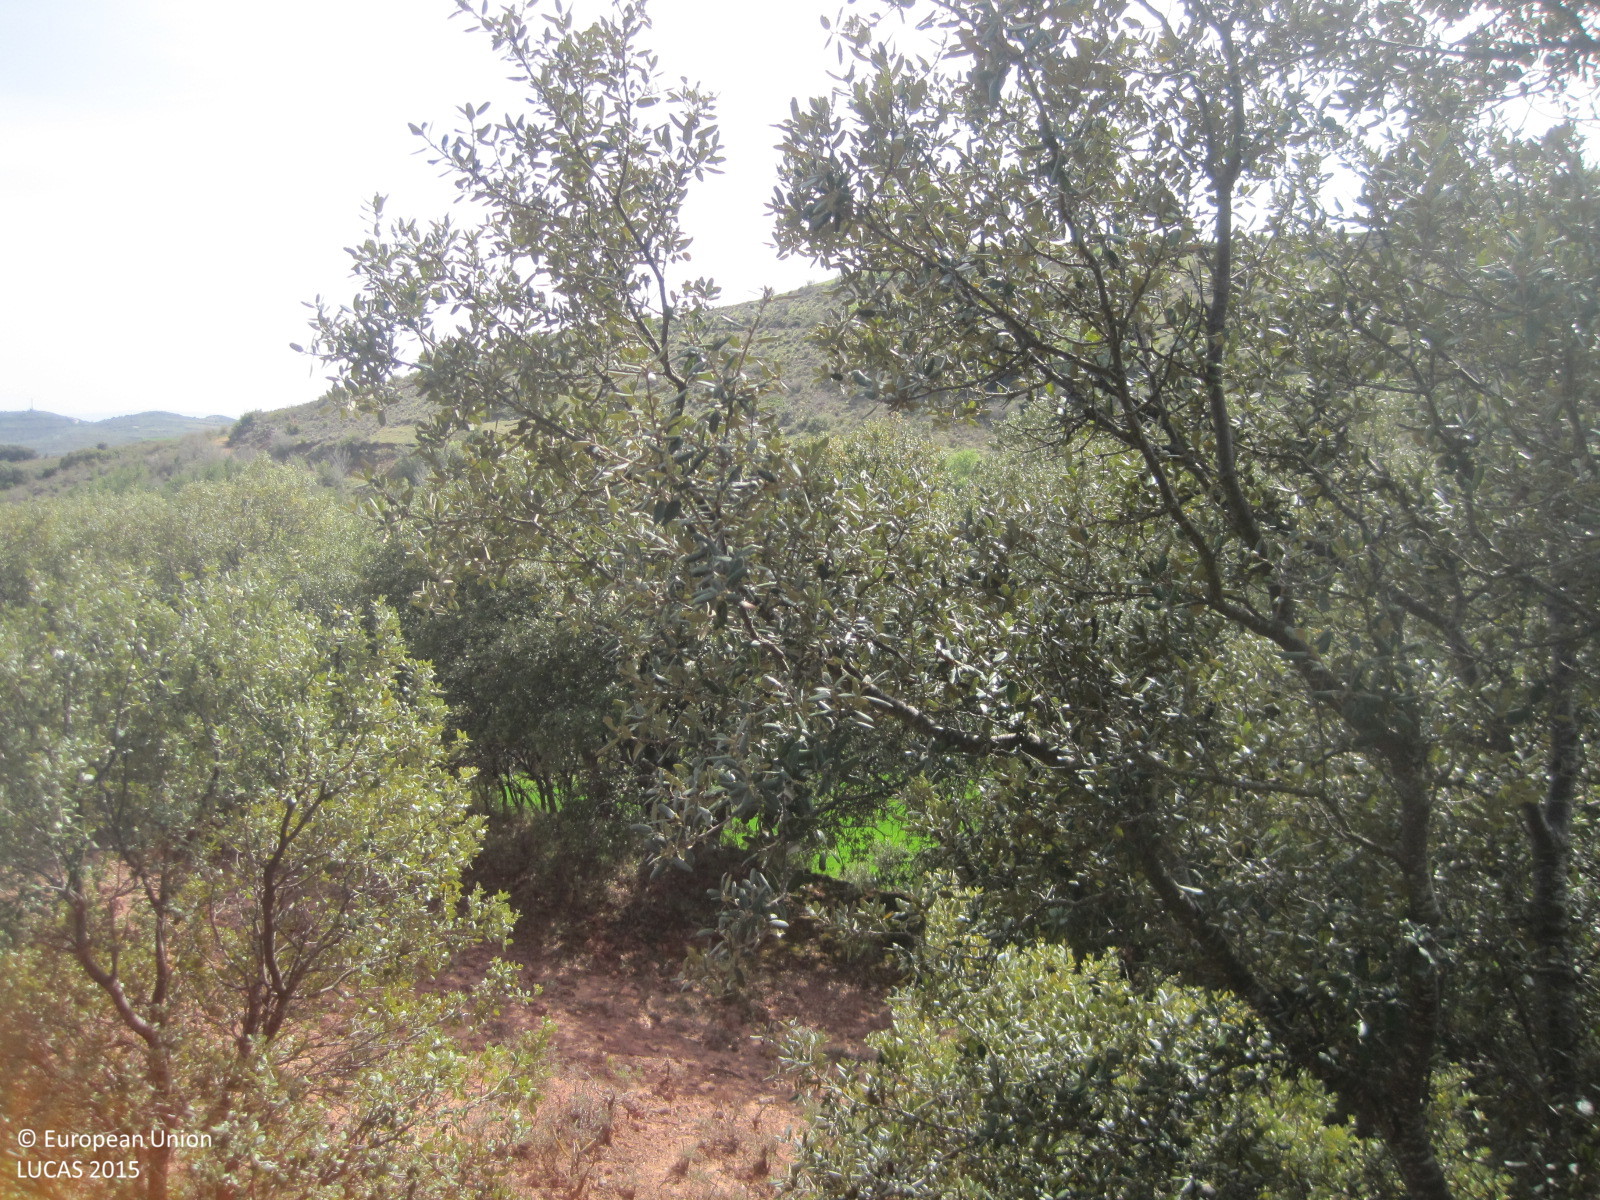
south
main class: Woodland
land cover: Broadleaved woodland
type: broadleaved evergreen forest
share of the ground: 50 - 75 %
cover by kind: broadleaved forest trees 50 %, shrubs 30 %, unconsolidated bare surface 15 %, consolidated bare surface 5 %
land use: Semi-natural and natural areas not in use
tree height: > 5 m
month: April
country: ES
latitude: 42.6133
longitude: -2.2959
